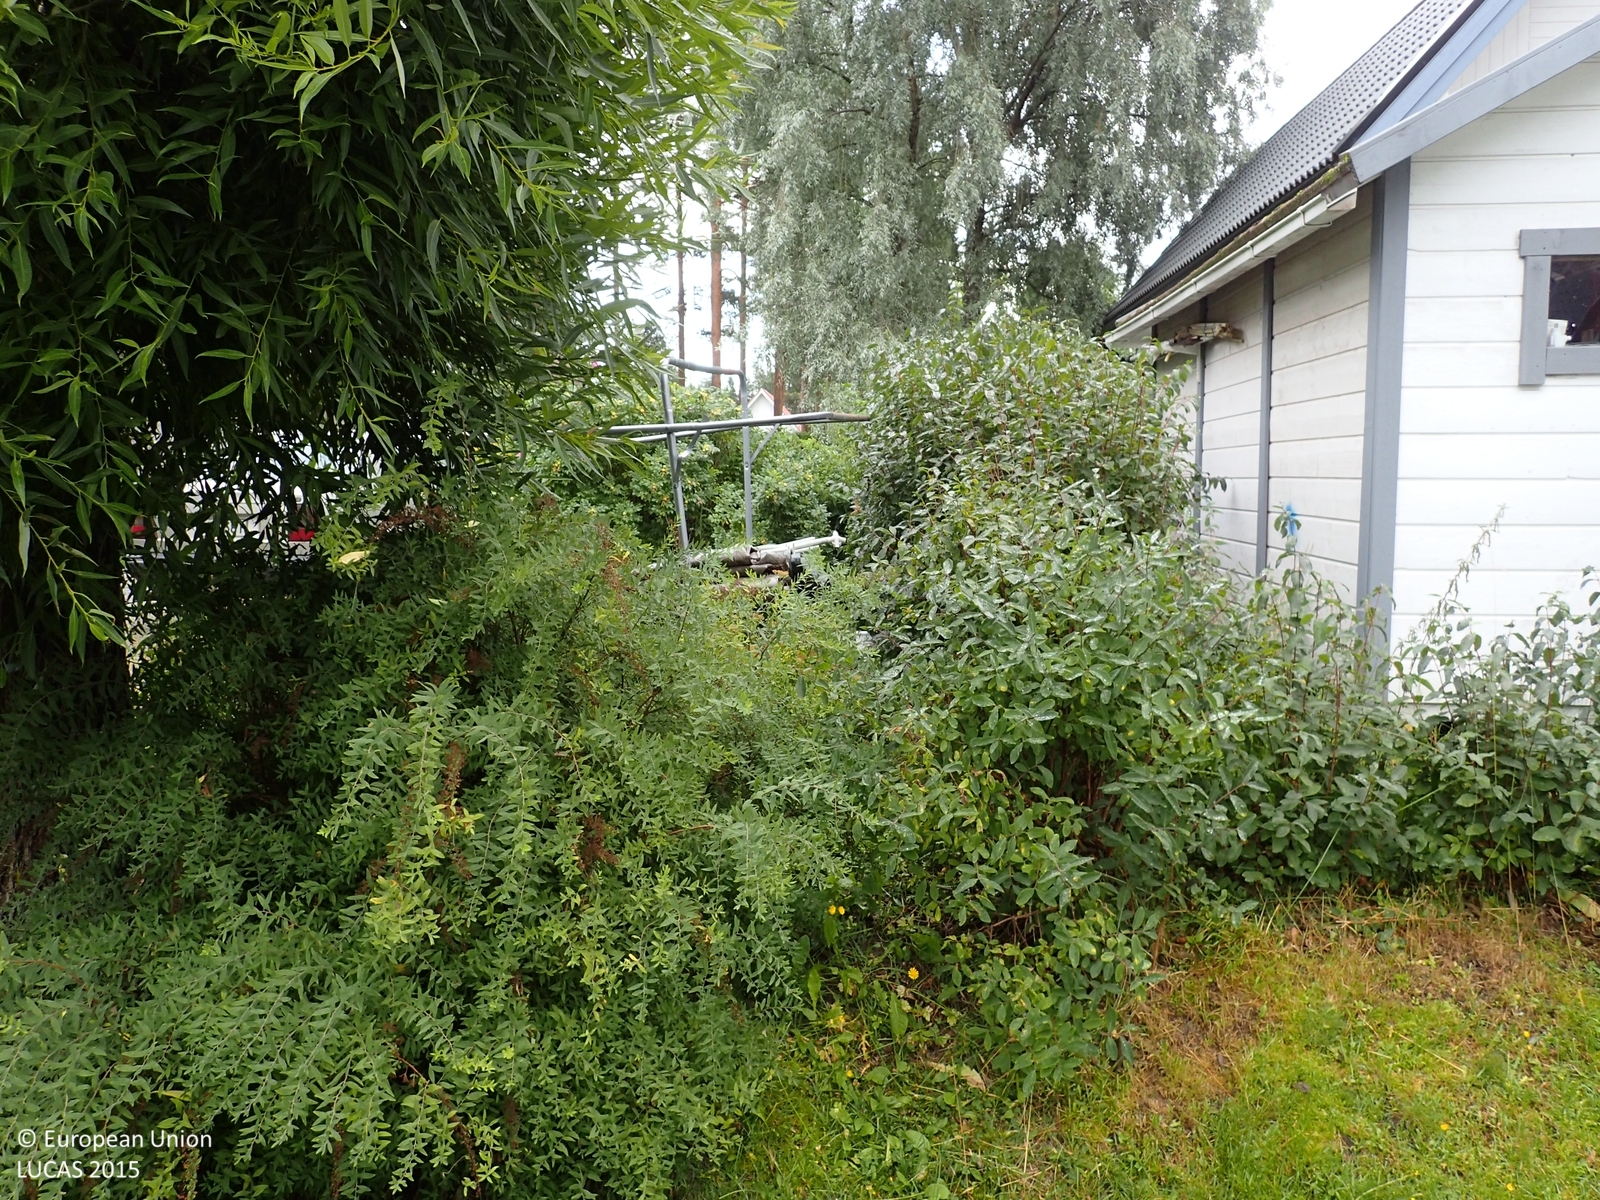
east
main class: Woodland
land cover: Broadleaved woodland
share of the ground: > 75 %
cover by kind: broadleaved forest trees 85 %, herbaceous plants 15 %
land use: Residential
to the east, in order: Broadleaved woodland; Artificial constructions in urban areas
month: August
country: FI
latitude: 62.7797
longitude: 22.7752
